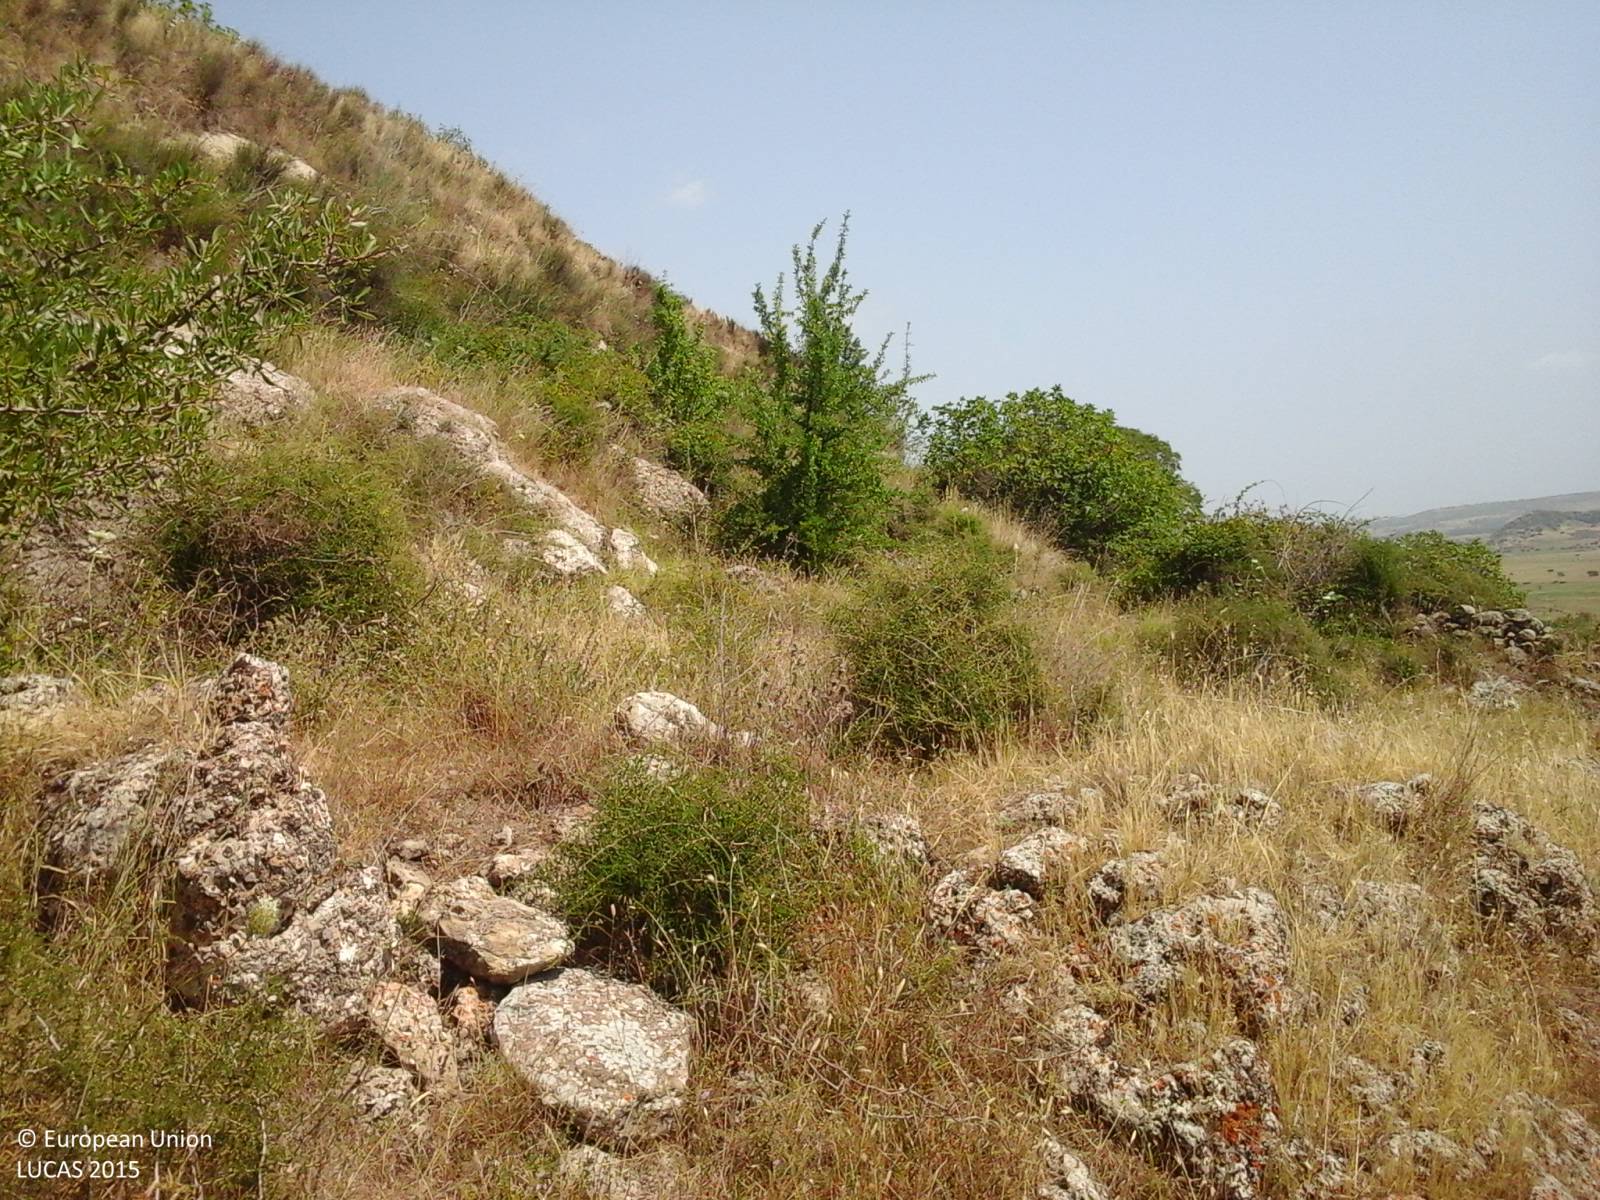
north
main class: Grassland
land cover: Grassland without tree/shrub cover
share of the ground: 25 - 50 %
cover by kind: herbaceous plants 100 %
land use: Agriculture (excluding fallow land and kitchen gardens)
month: July
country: IT
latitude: 40.4231
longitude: 8.8156
